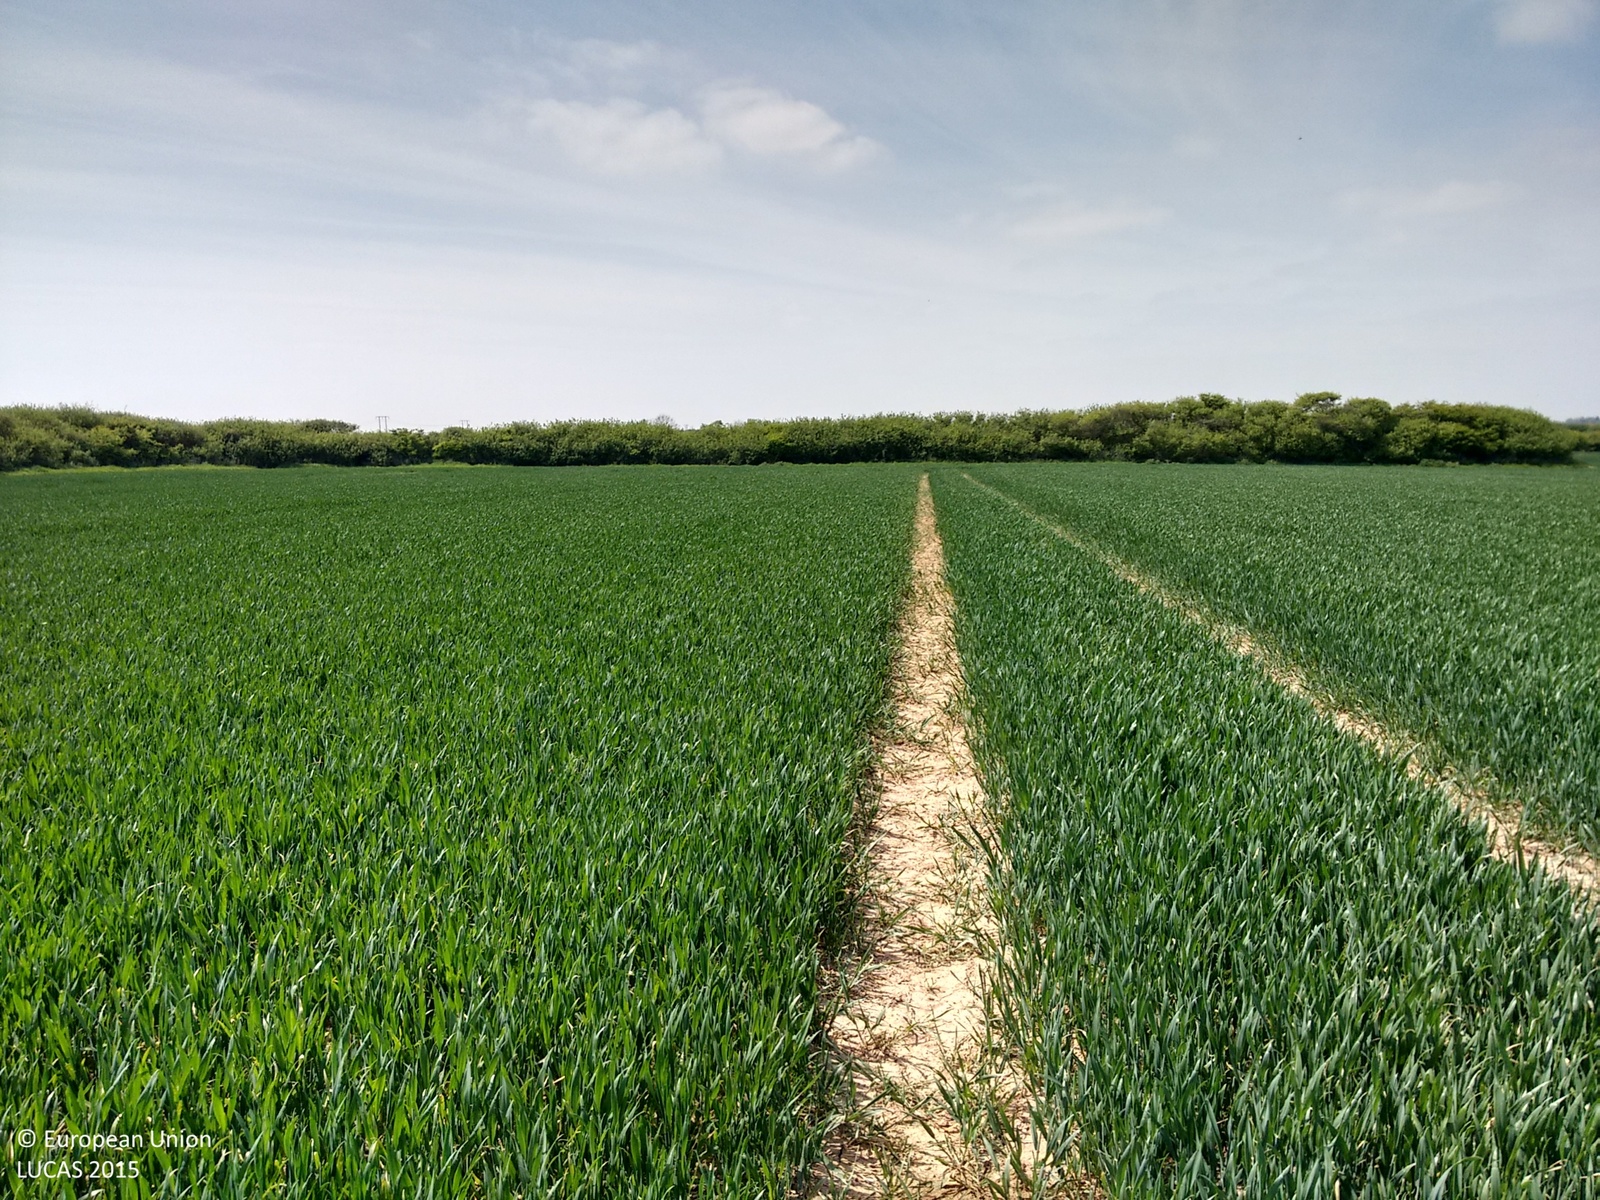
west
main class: Cropland
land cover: Common wheat
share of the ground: > 75 %
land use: Agriculture (excluding fallow land and kitchen gardens)
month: May
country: GB
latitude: 53.6646
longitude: 0.0868
